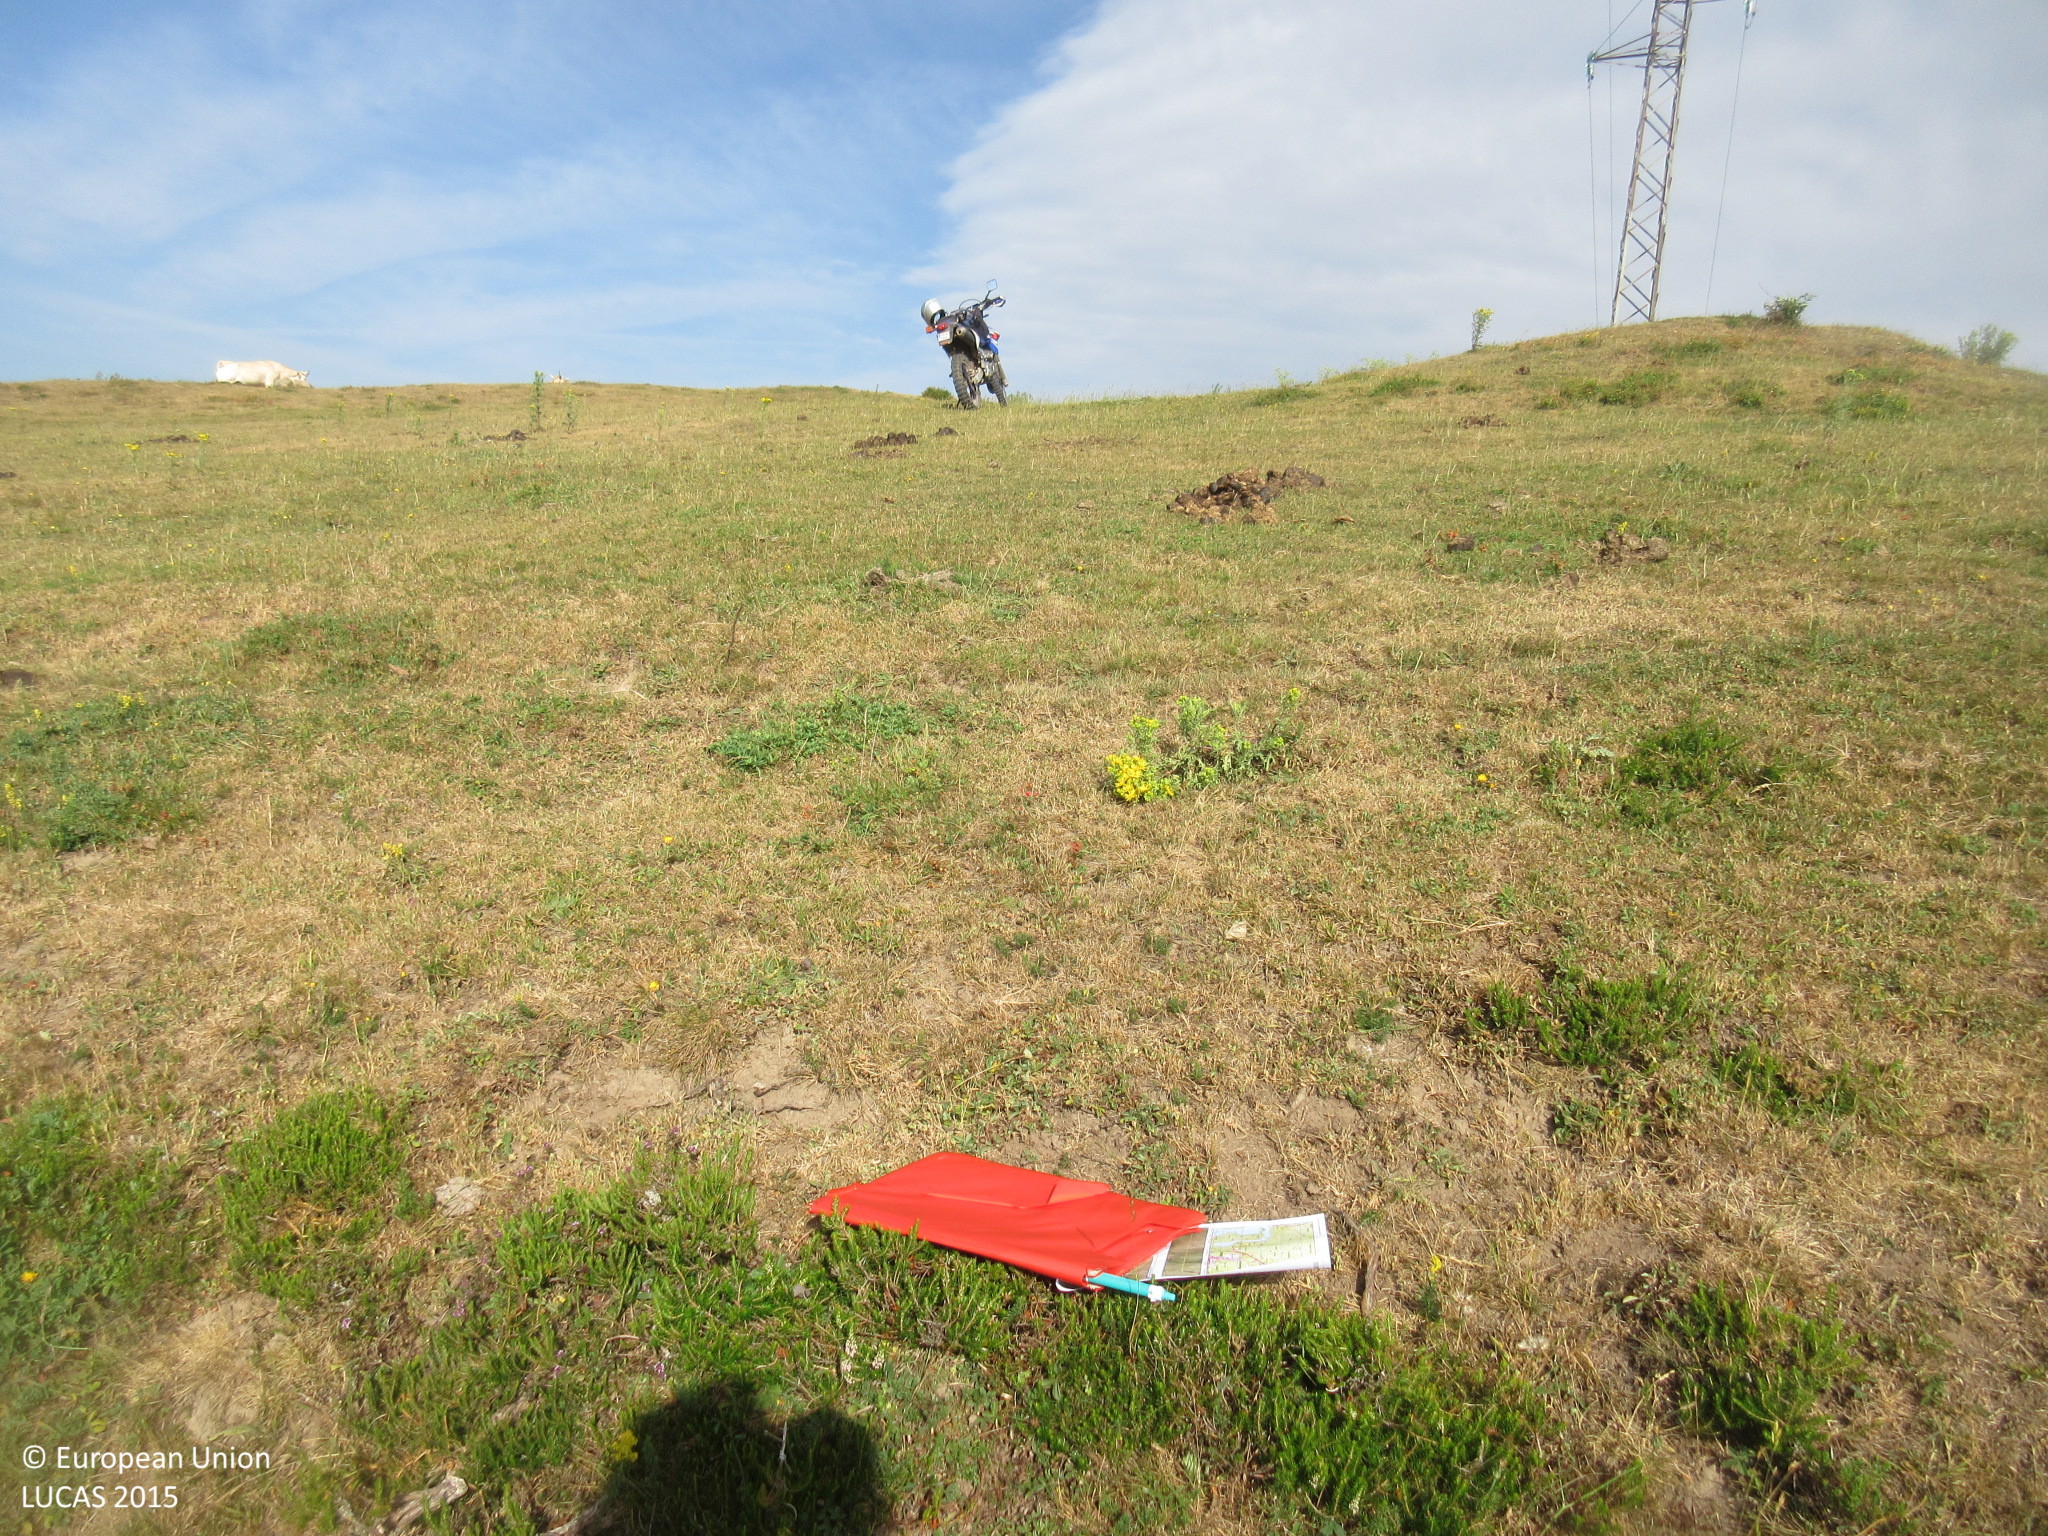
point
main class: Grassland
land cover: Grassland without tree/shrub cover
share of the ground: > 75 %
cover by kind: herbaceous plants 100 %
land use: Agriculture (excluding fallow land and kitchen gardens)
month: July
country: ES
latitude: 42.9777
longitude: -4.1144
